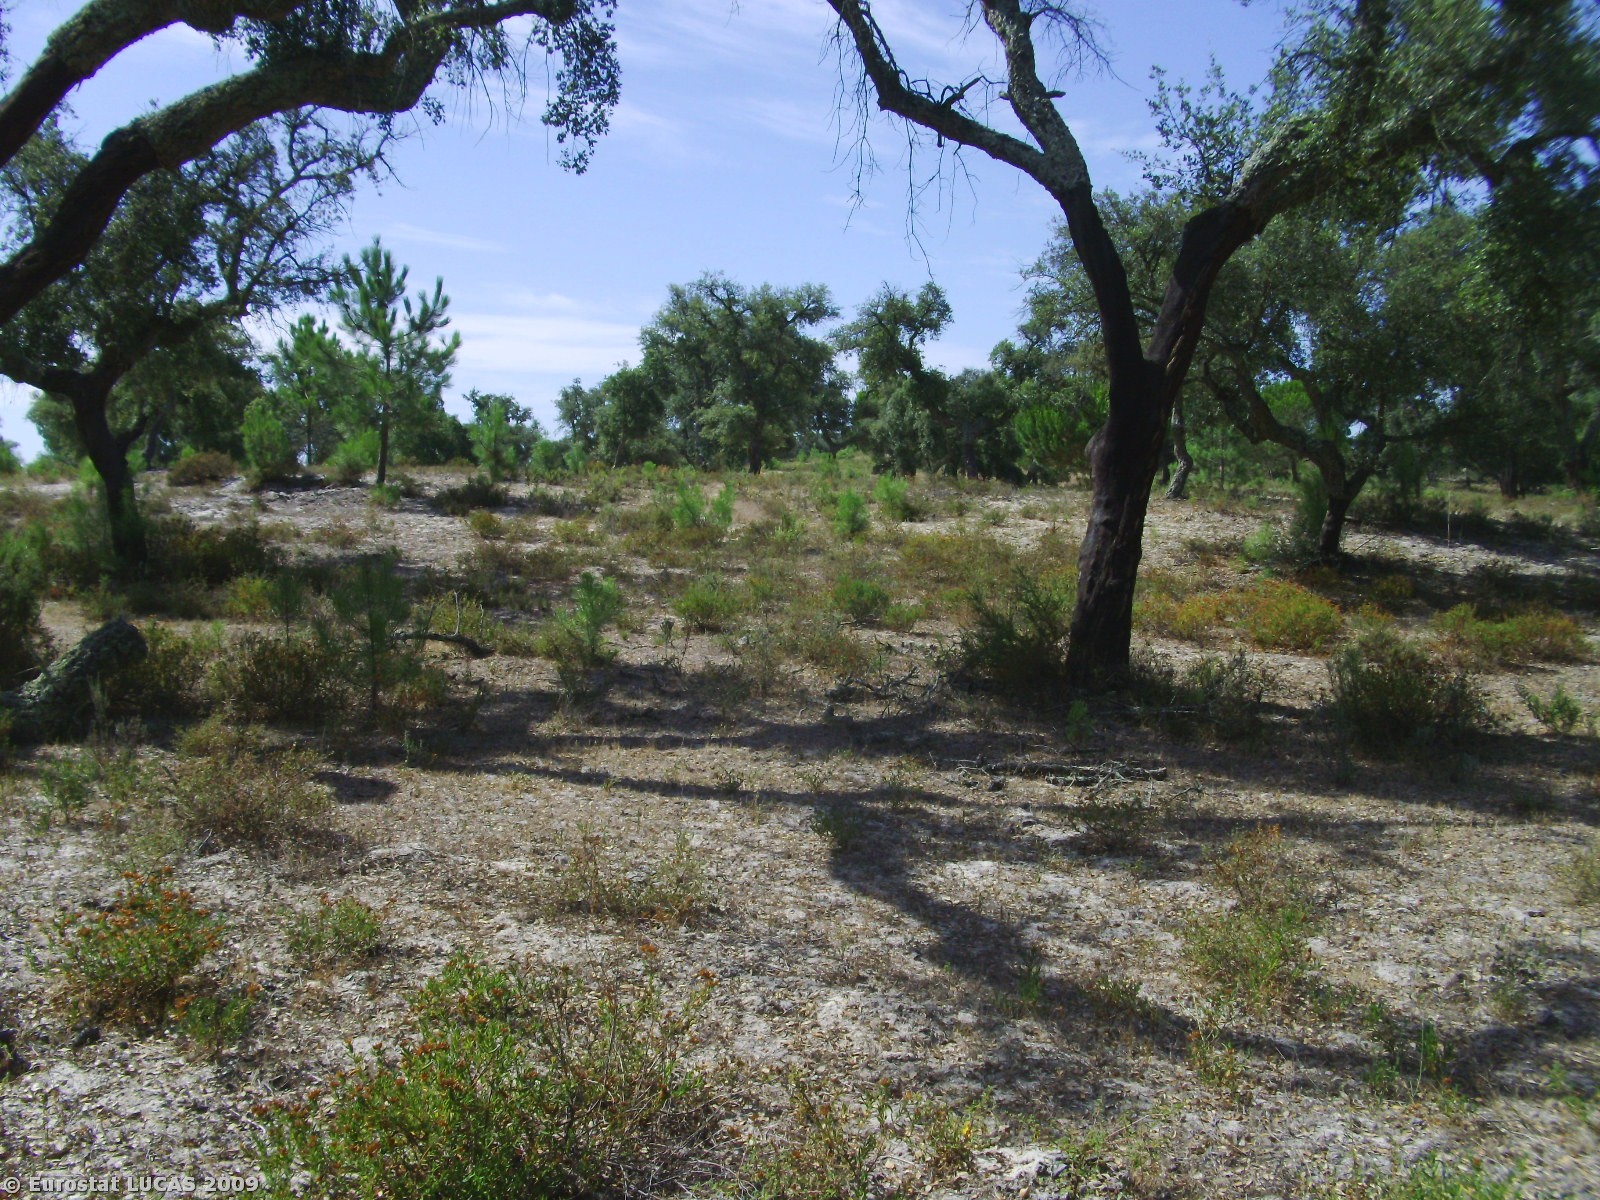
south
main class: Woodland
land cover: Broadleaved woodland
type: broadleaved evergreen forest
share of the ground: 25 - 50 %
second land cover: Spontaneously vegetated surfaces
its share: 50 - 75 %
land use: Forestry
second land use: Fallow land
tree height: > 5 m
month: August
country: PT
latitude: 38.5694
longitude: -8.6637
